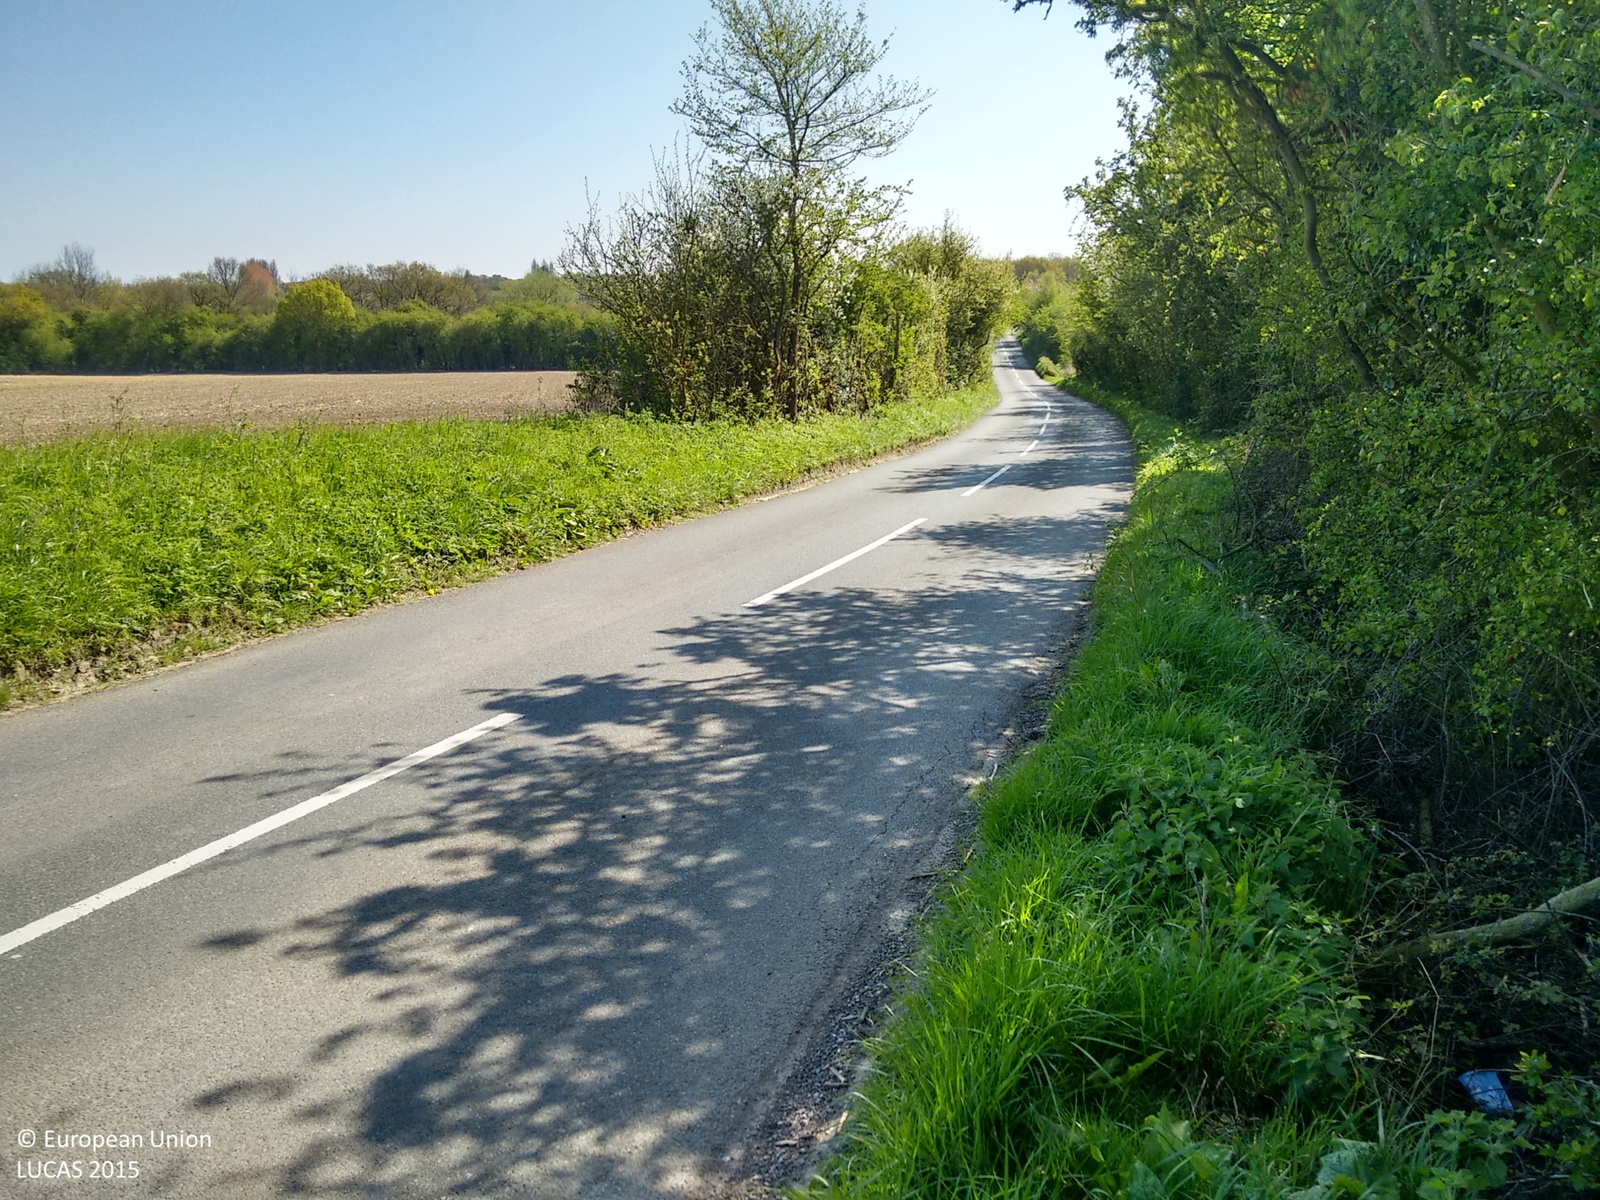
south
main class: Grassland
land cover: Grassland without tree/shrub cover
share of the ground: > 75 %
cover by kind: herbaceous plants 100 %
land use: Agriculture (excluding fallow land and kitchen gardens)
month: April
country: GB
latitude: 51.4385
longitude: 0.5497
